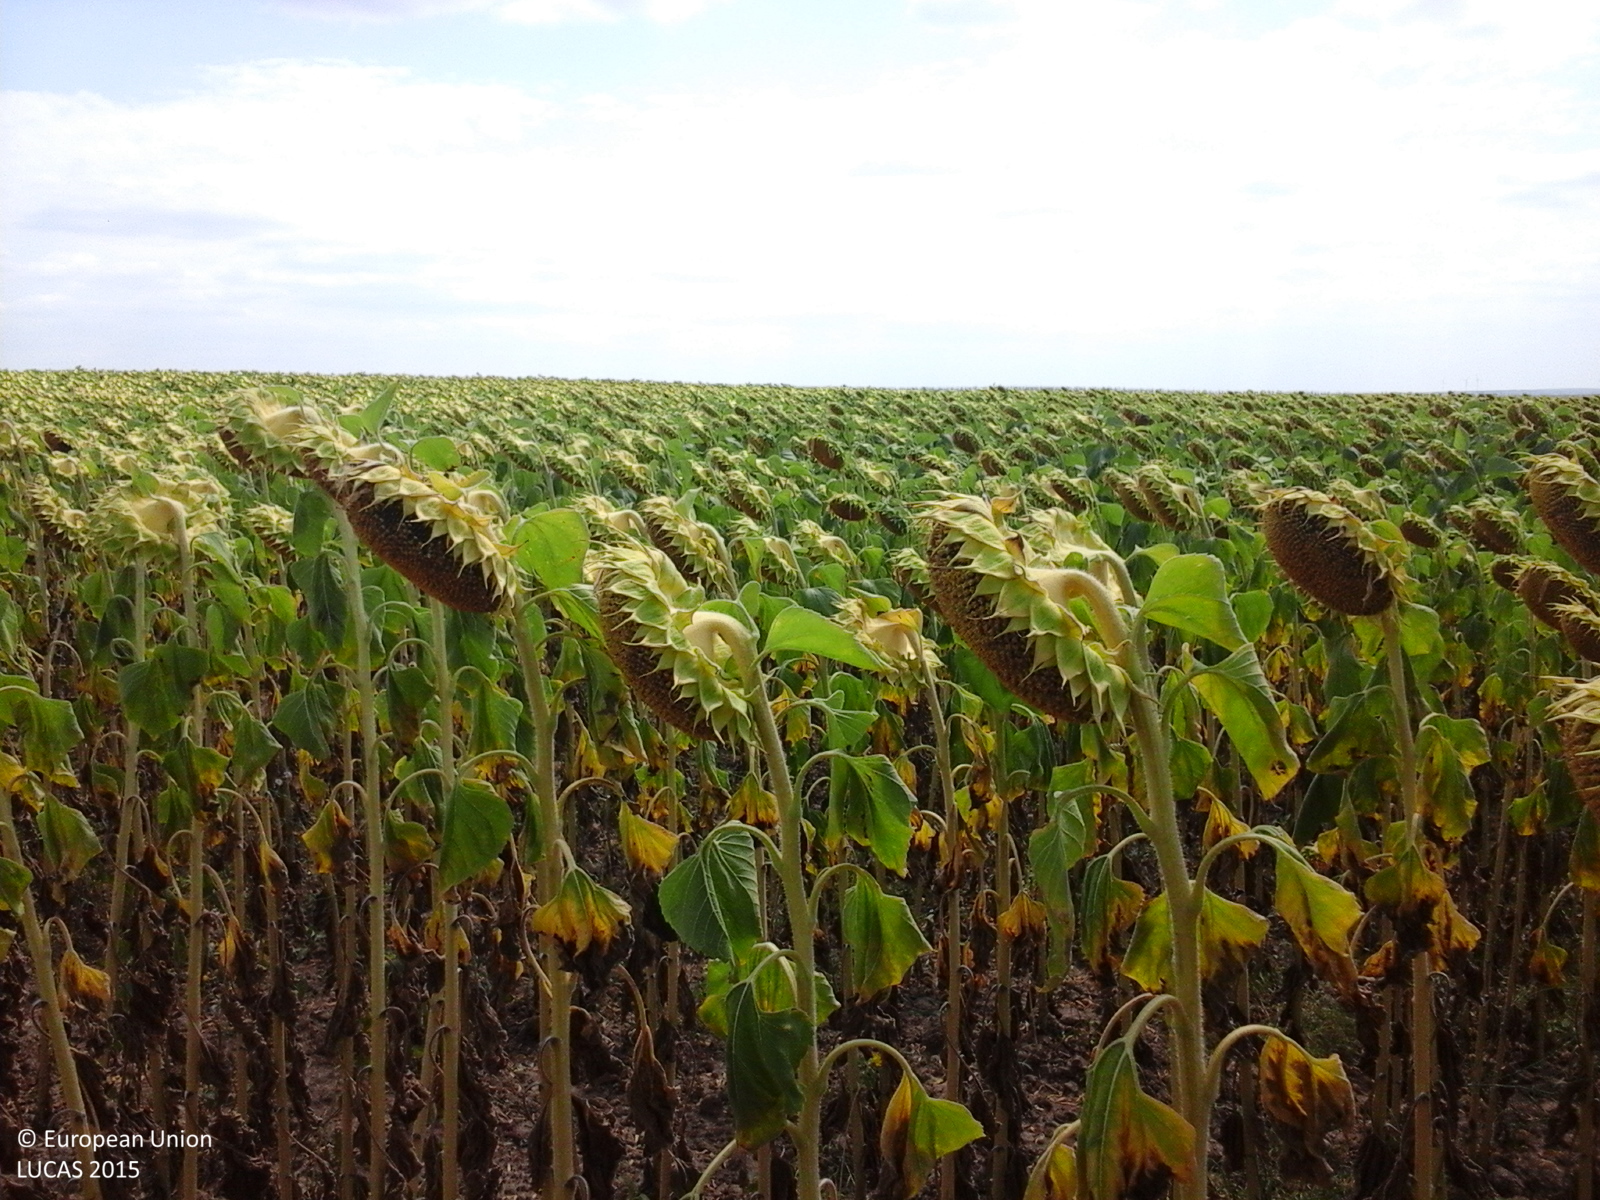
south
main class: Cropland
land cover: Sunflower
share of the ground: > 75 %
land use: Agriculture (excluding fallow land and kitchen gardens)
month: August
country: RO
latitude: 44.7945
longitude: 28.1800
